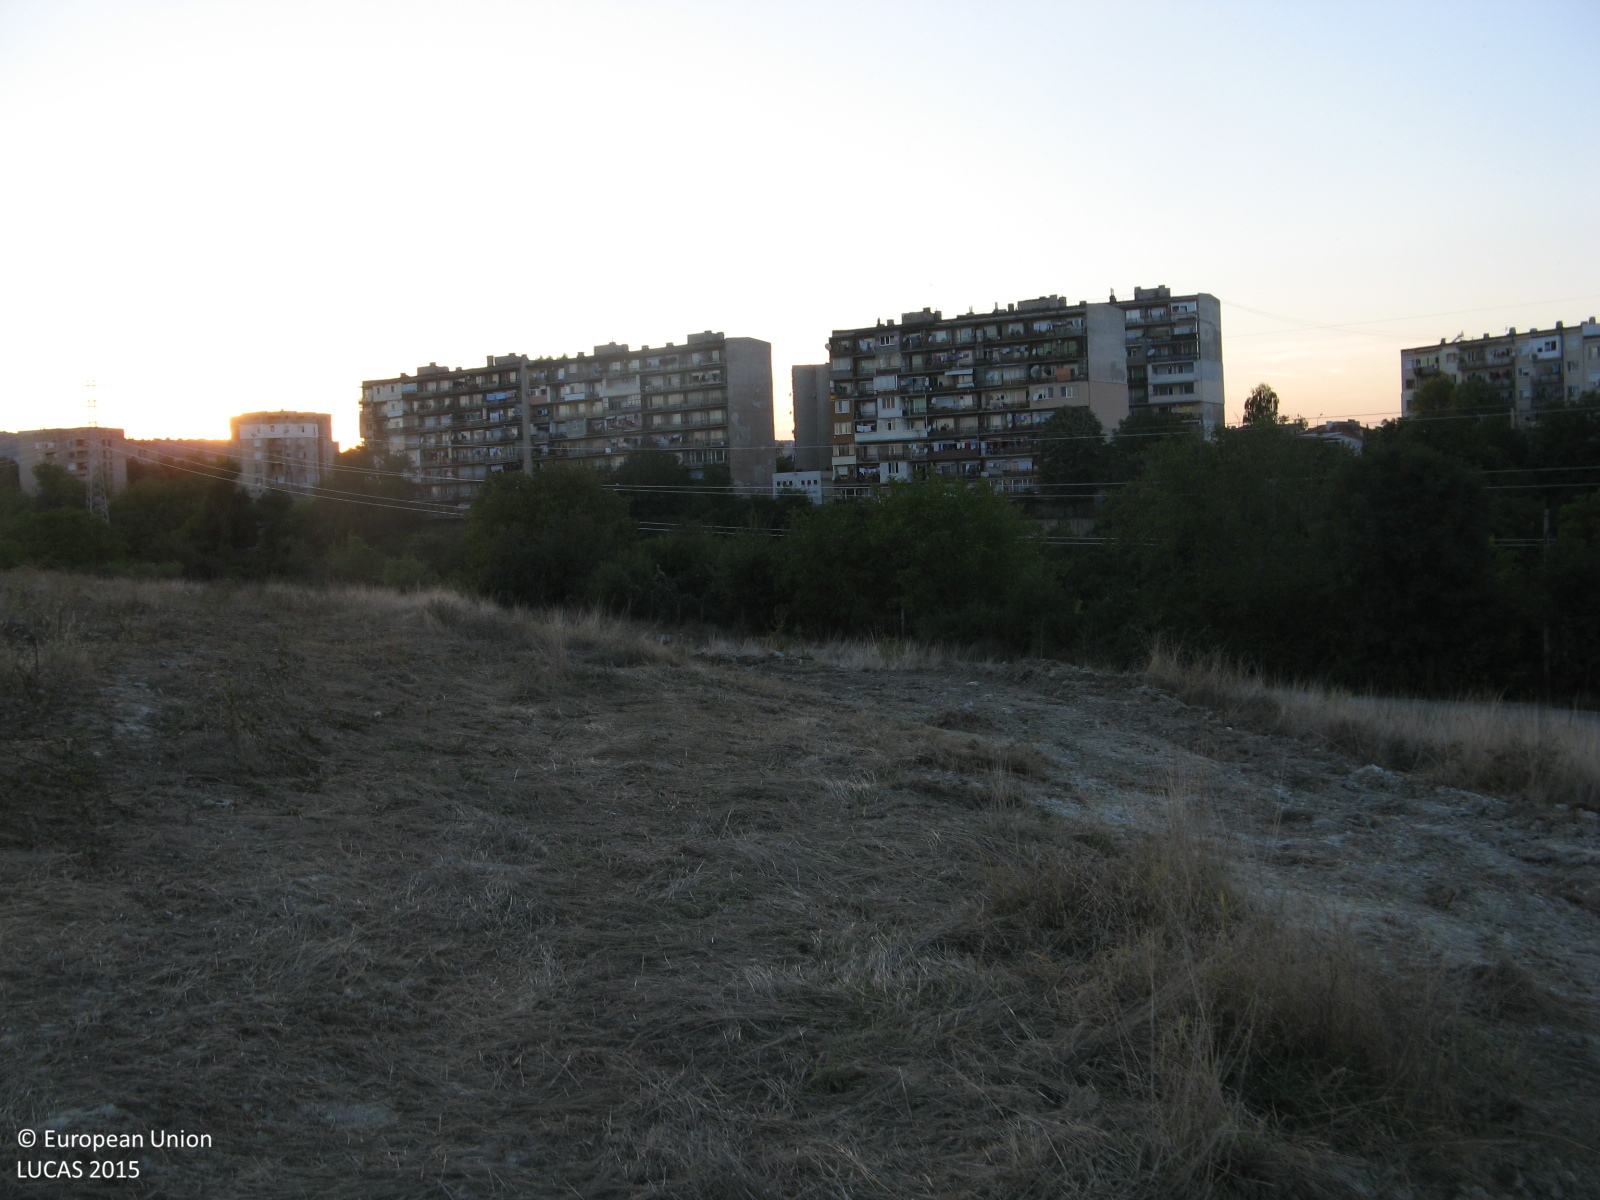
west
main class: Grassland
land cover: Spontaneously vegetated surfaces
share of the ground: > 75 %
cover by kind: herbaceous plants 100 %
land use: Fallow land
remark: Harvested field
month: October
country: BG
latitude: 41.6177
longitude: 25.3823
